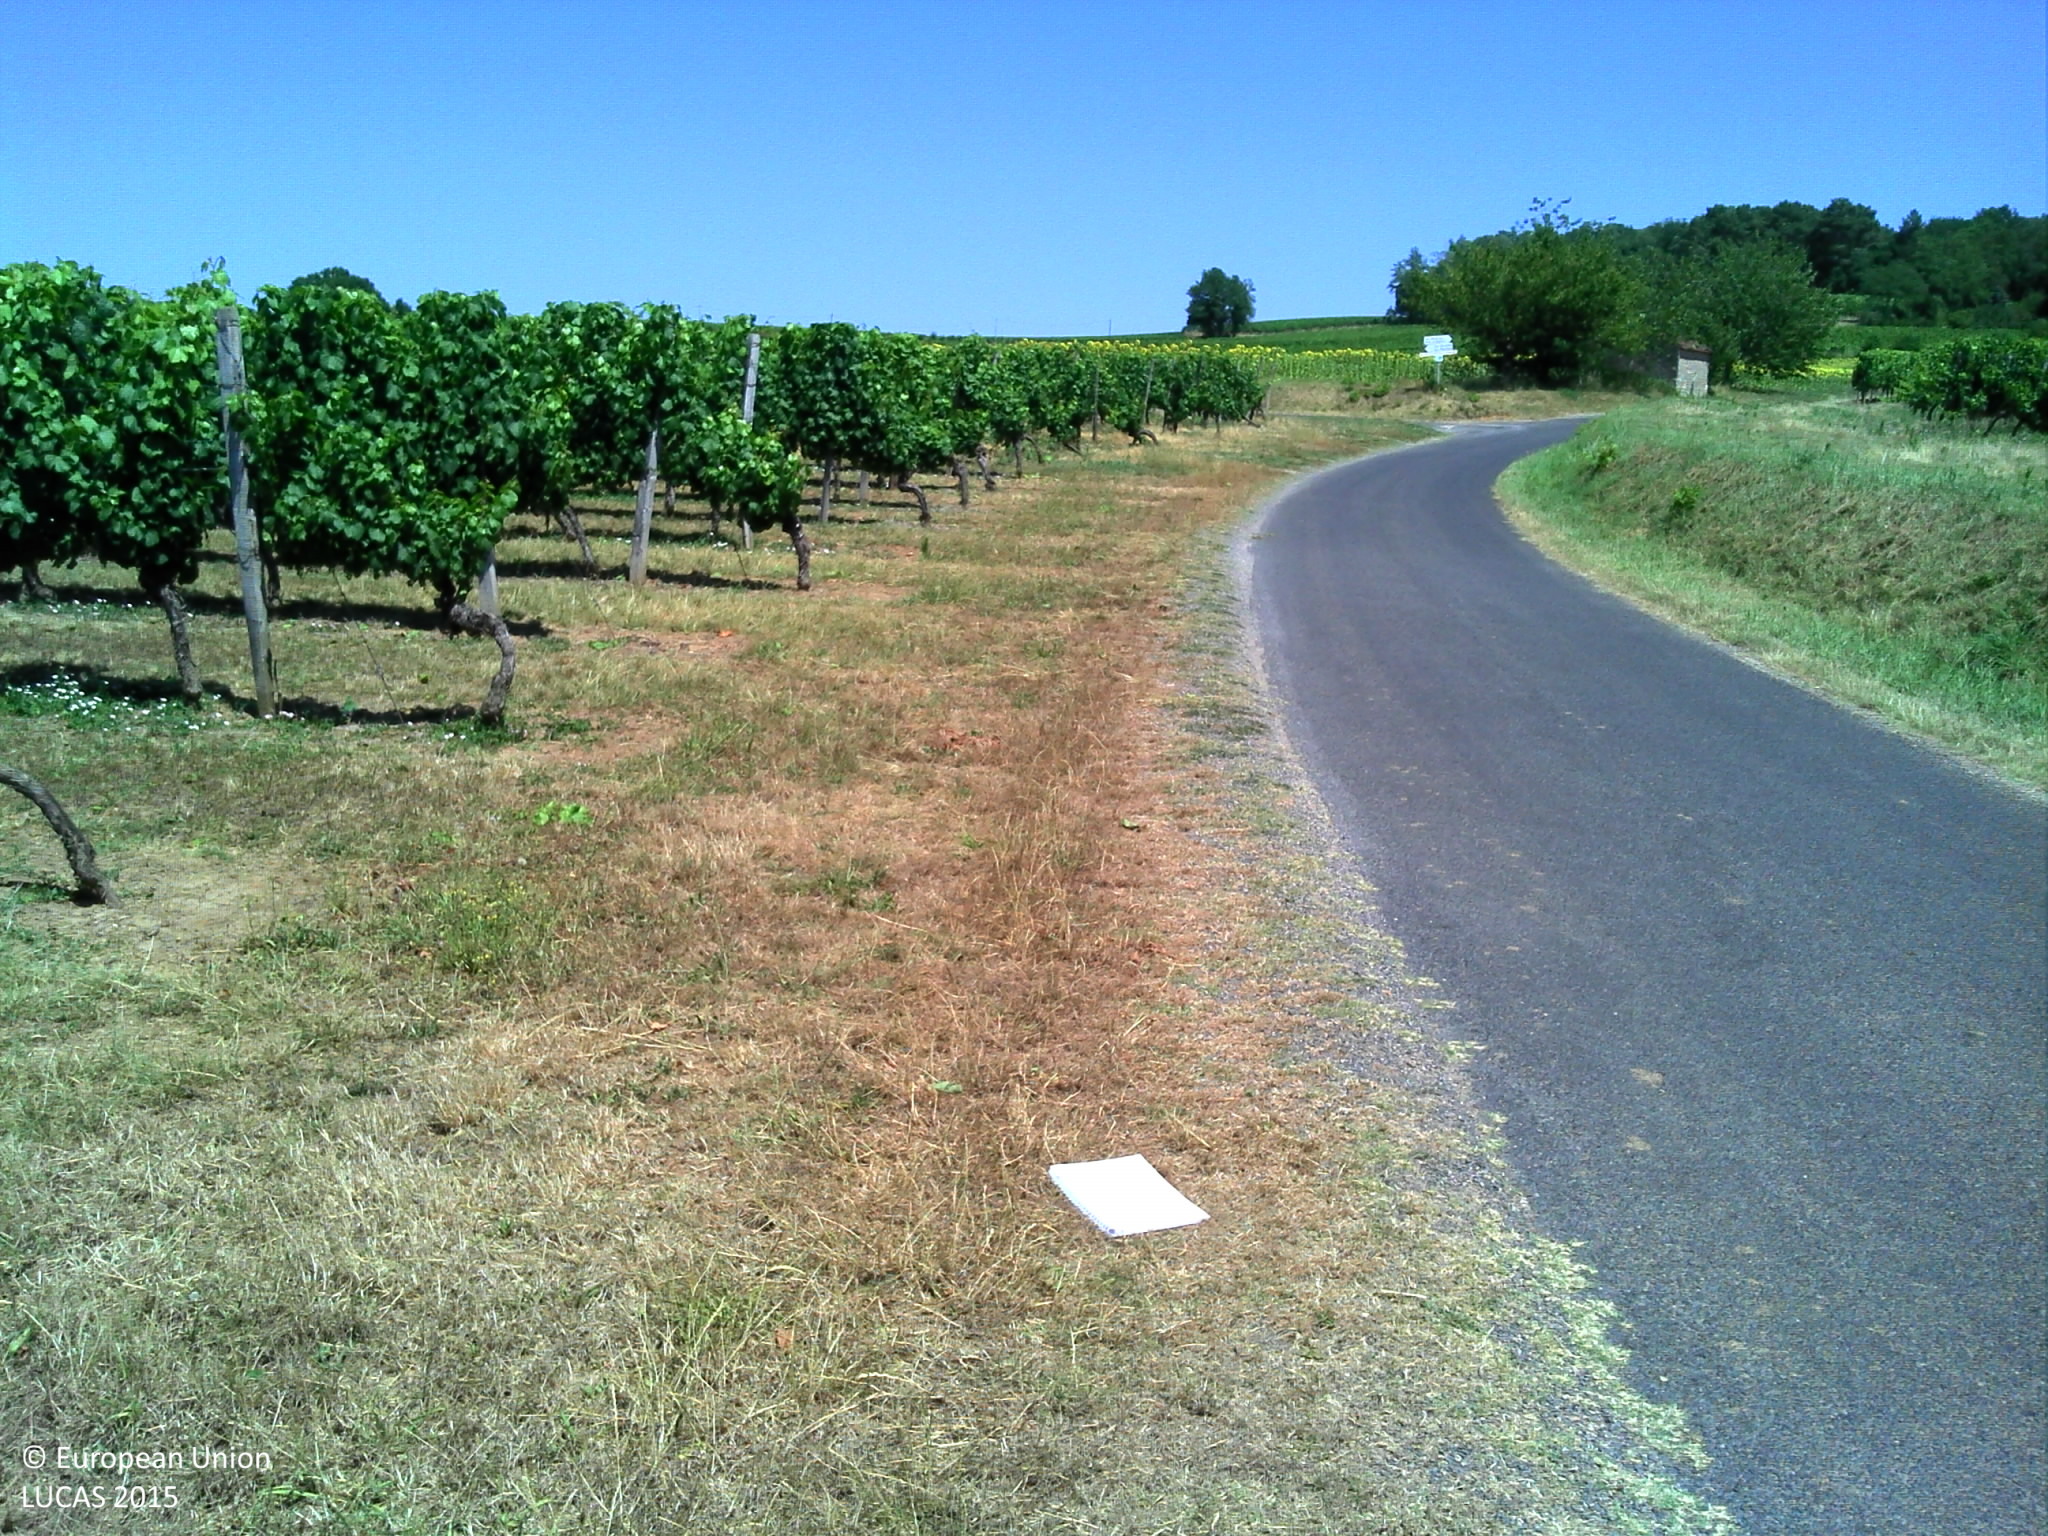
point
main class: Cropland
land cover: Vineyards
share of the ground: > 75 %
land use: Agriculture (excluding fallow land and kitchen gardens)
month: July
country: FR
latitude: 44.4845
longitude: 1.2077
